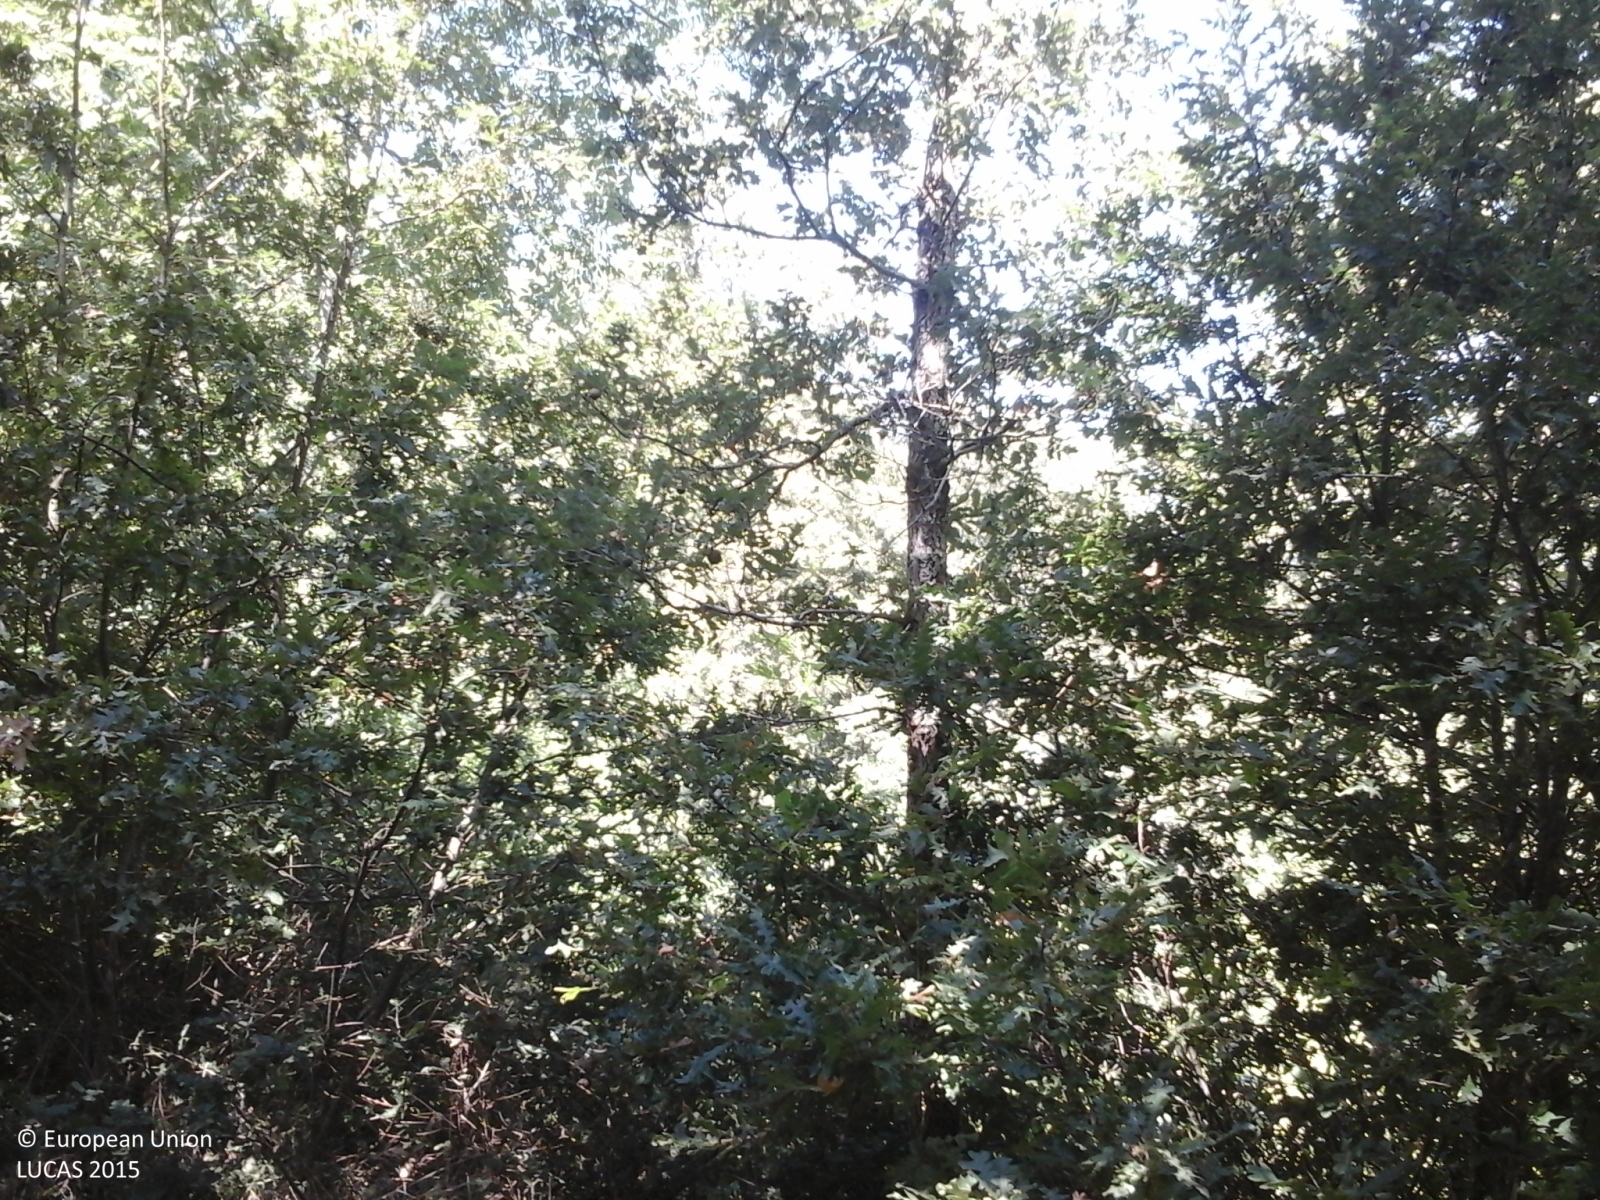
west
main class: Woodland
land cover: Broadleaved woodland
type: thermophilous deciduous forest
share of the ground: > 75 %
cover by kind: broadleaved forest trees 70 %, shrubs 10 %, herbaceous plants 5 %, lichens and mosses 5 %
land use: Forestry
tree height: > 5 m
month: July
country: IT
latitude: 41.2950
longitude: 14.7236
